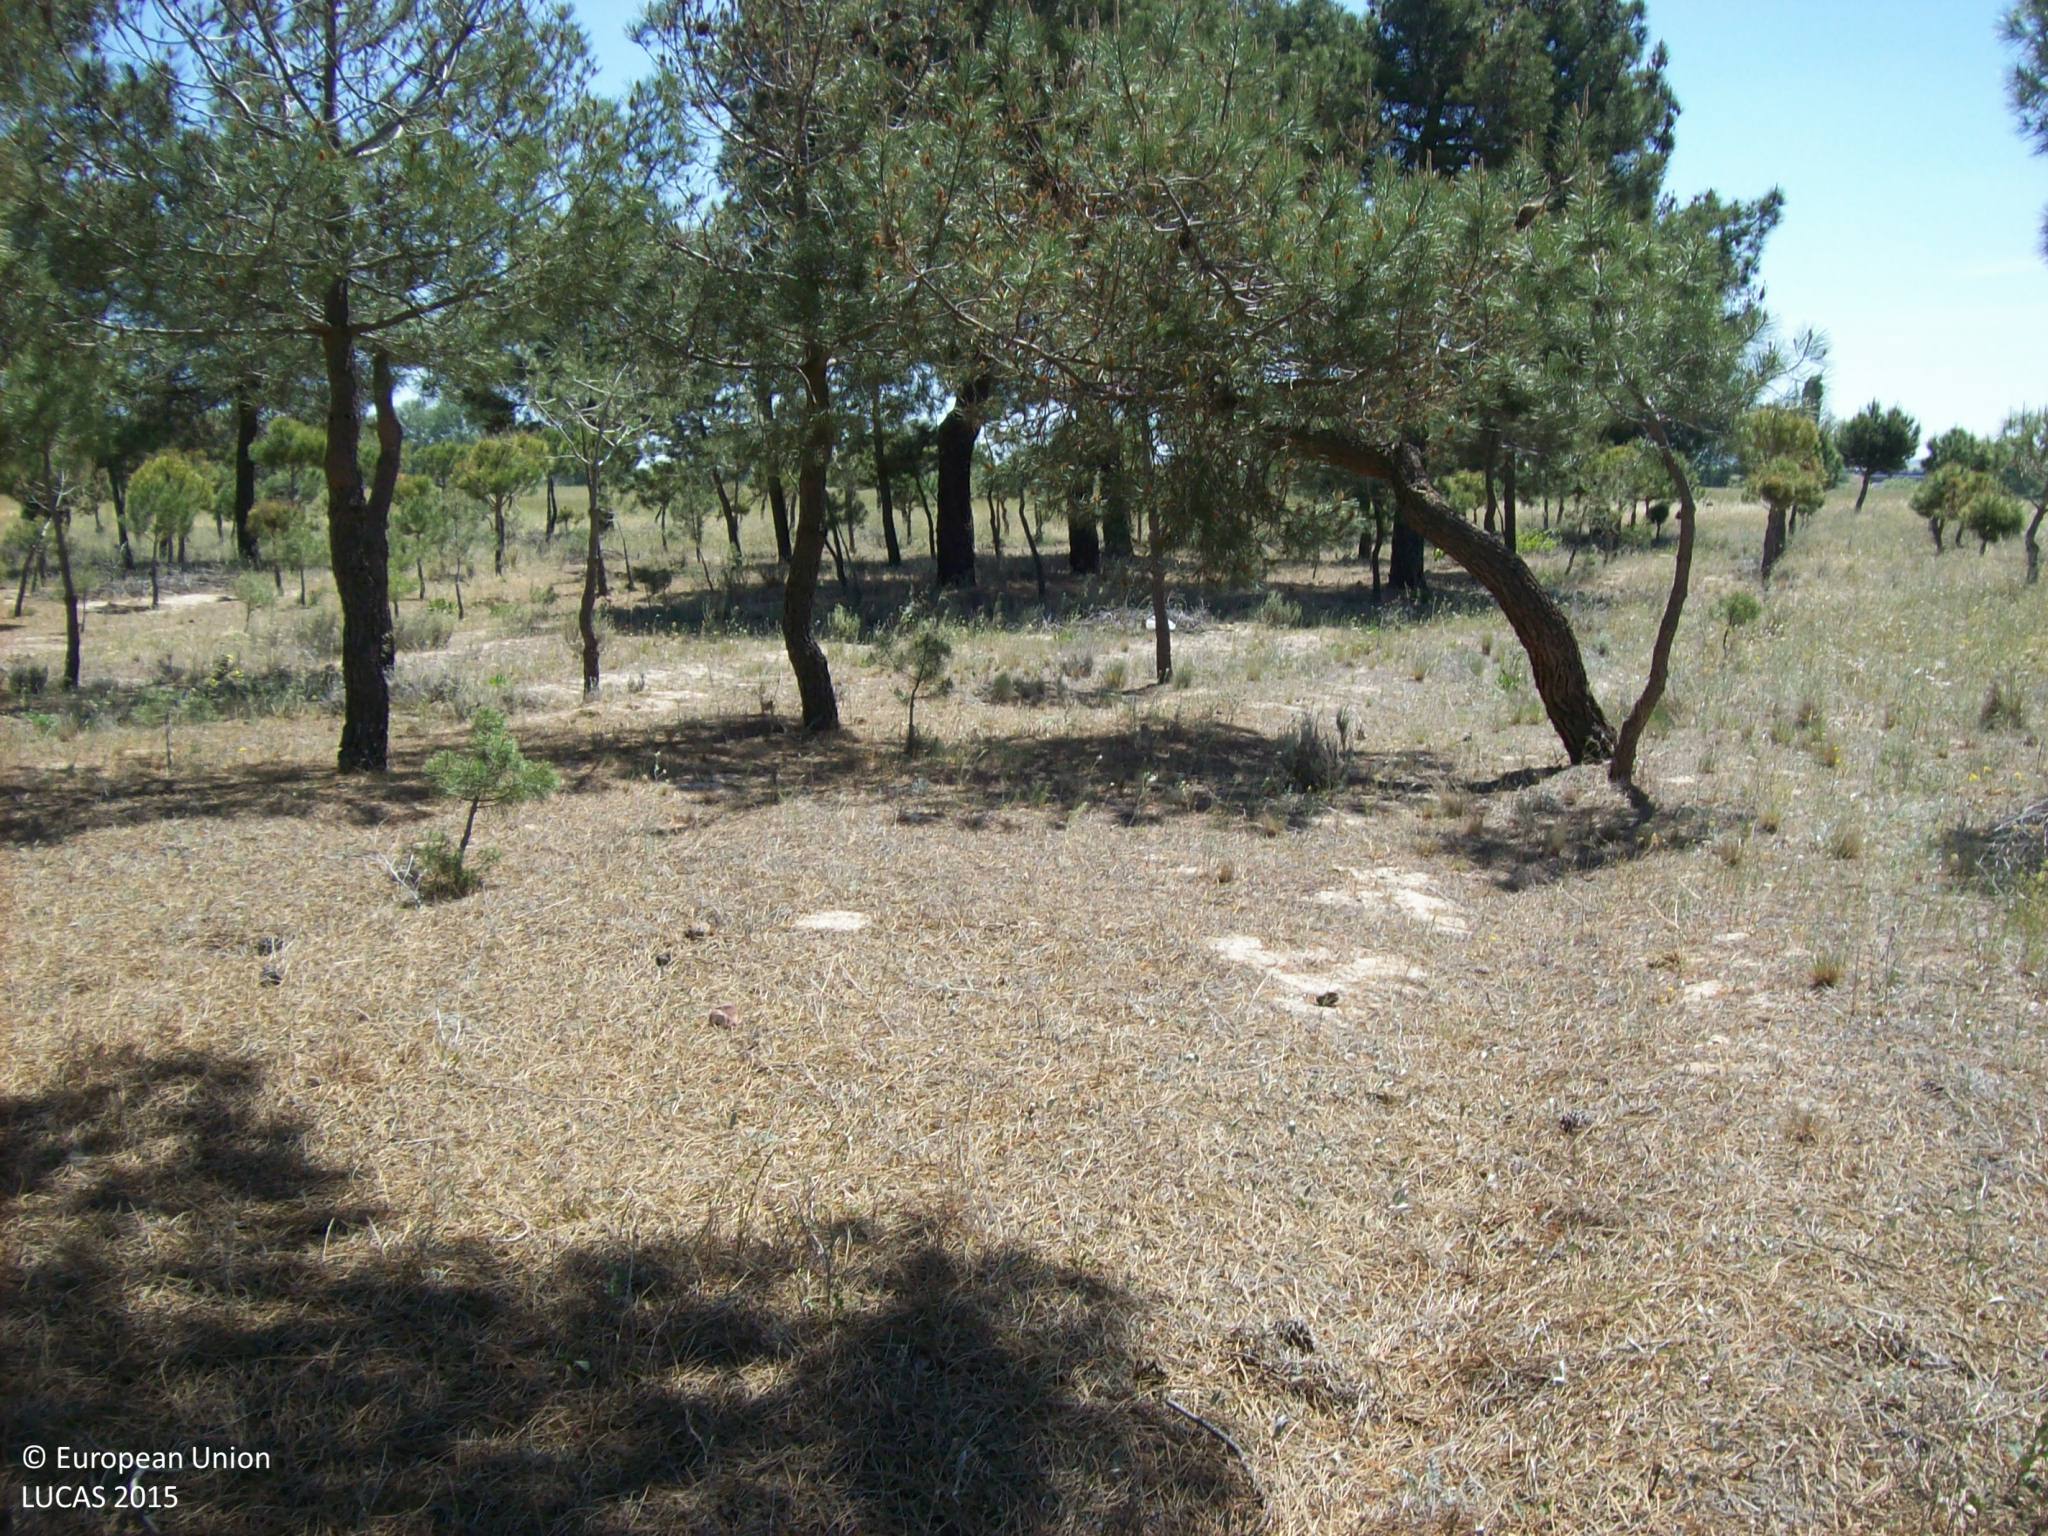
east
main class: Woodland
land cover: Pine dominated coniferous woodland
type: coniferous forest of the mediterranean region
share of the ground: 25 - 50 %
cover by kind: unconsolidated bare surface 50 %, coniferous forest trees 30 %, herbaceous plants 10 %
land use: Forestry
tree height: < 5 m
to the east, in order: Pine dominated coniferous woodland; Rye; Tracks; Common wheat
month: May
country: ES
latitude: 40.8125
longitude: -4.8915
